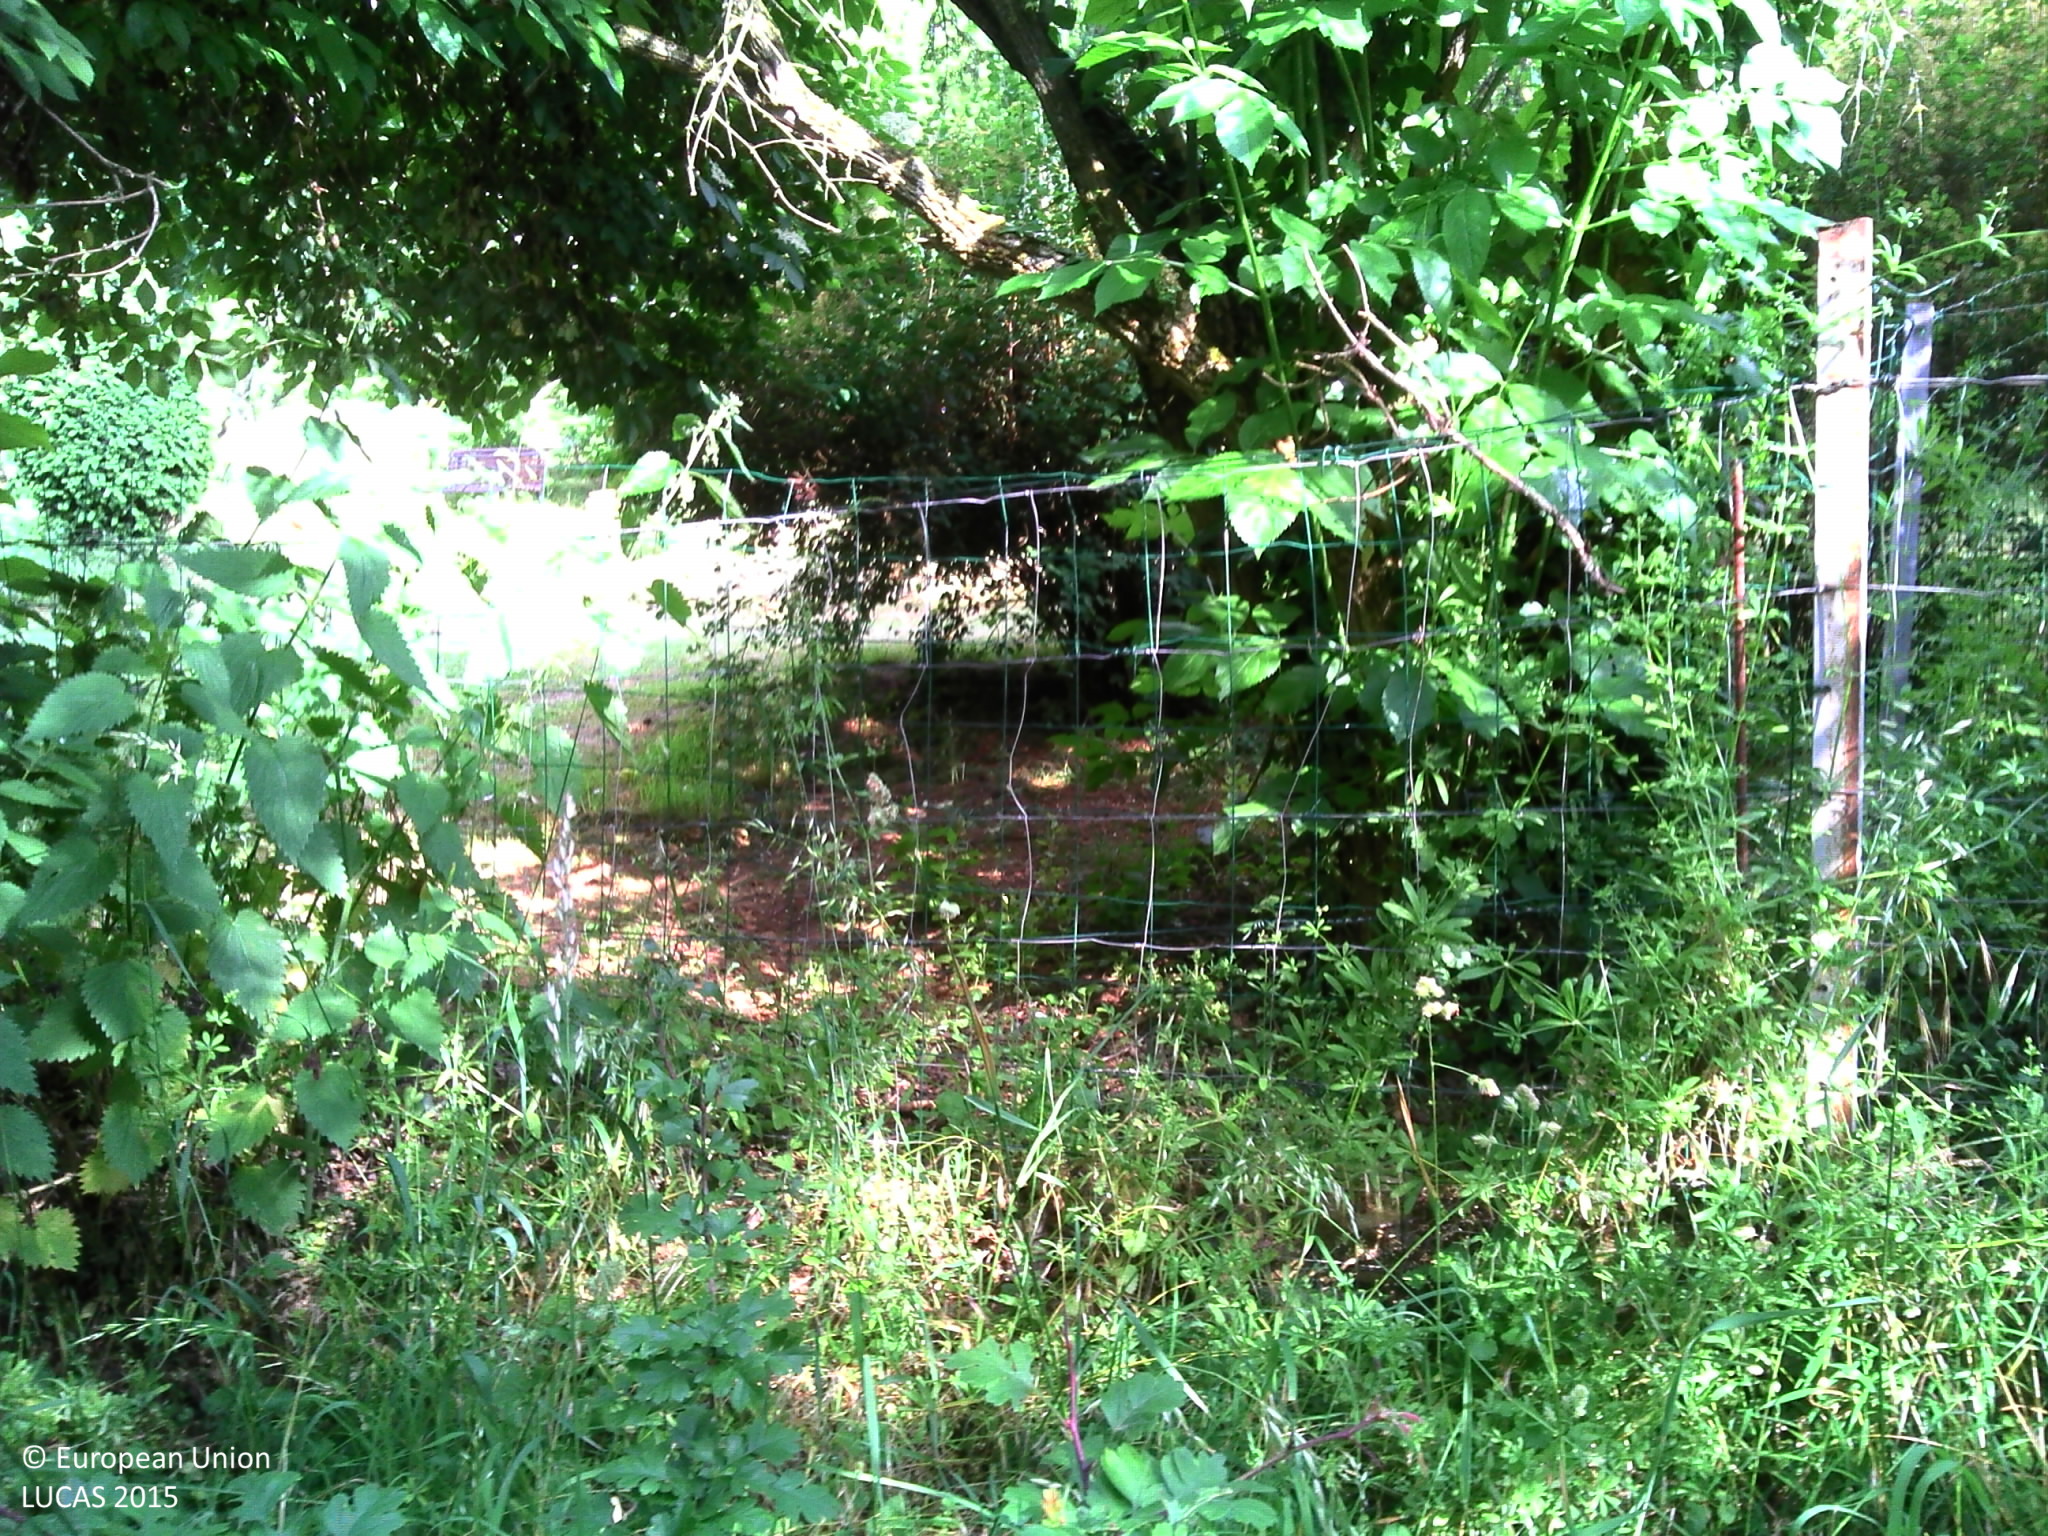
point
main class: Grassland
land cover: Grassland with sparse tree/shrub cover
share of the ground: > 75 %
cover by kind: herbaceous plants 95 %, broadleaved forest trees 5 %
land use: Residential
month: June
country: FR
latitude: 48.7554
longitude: 6.2867
